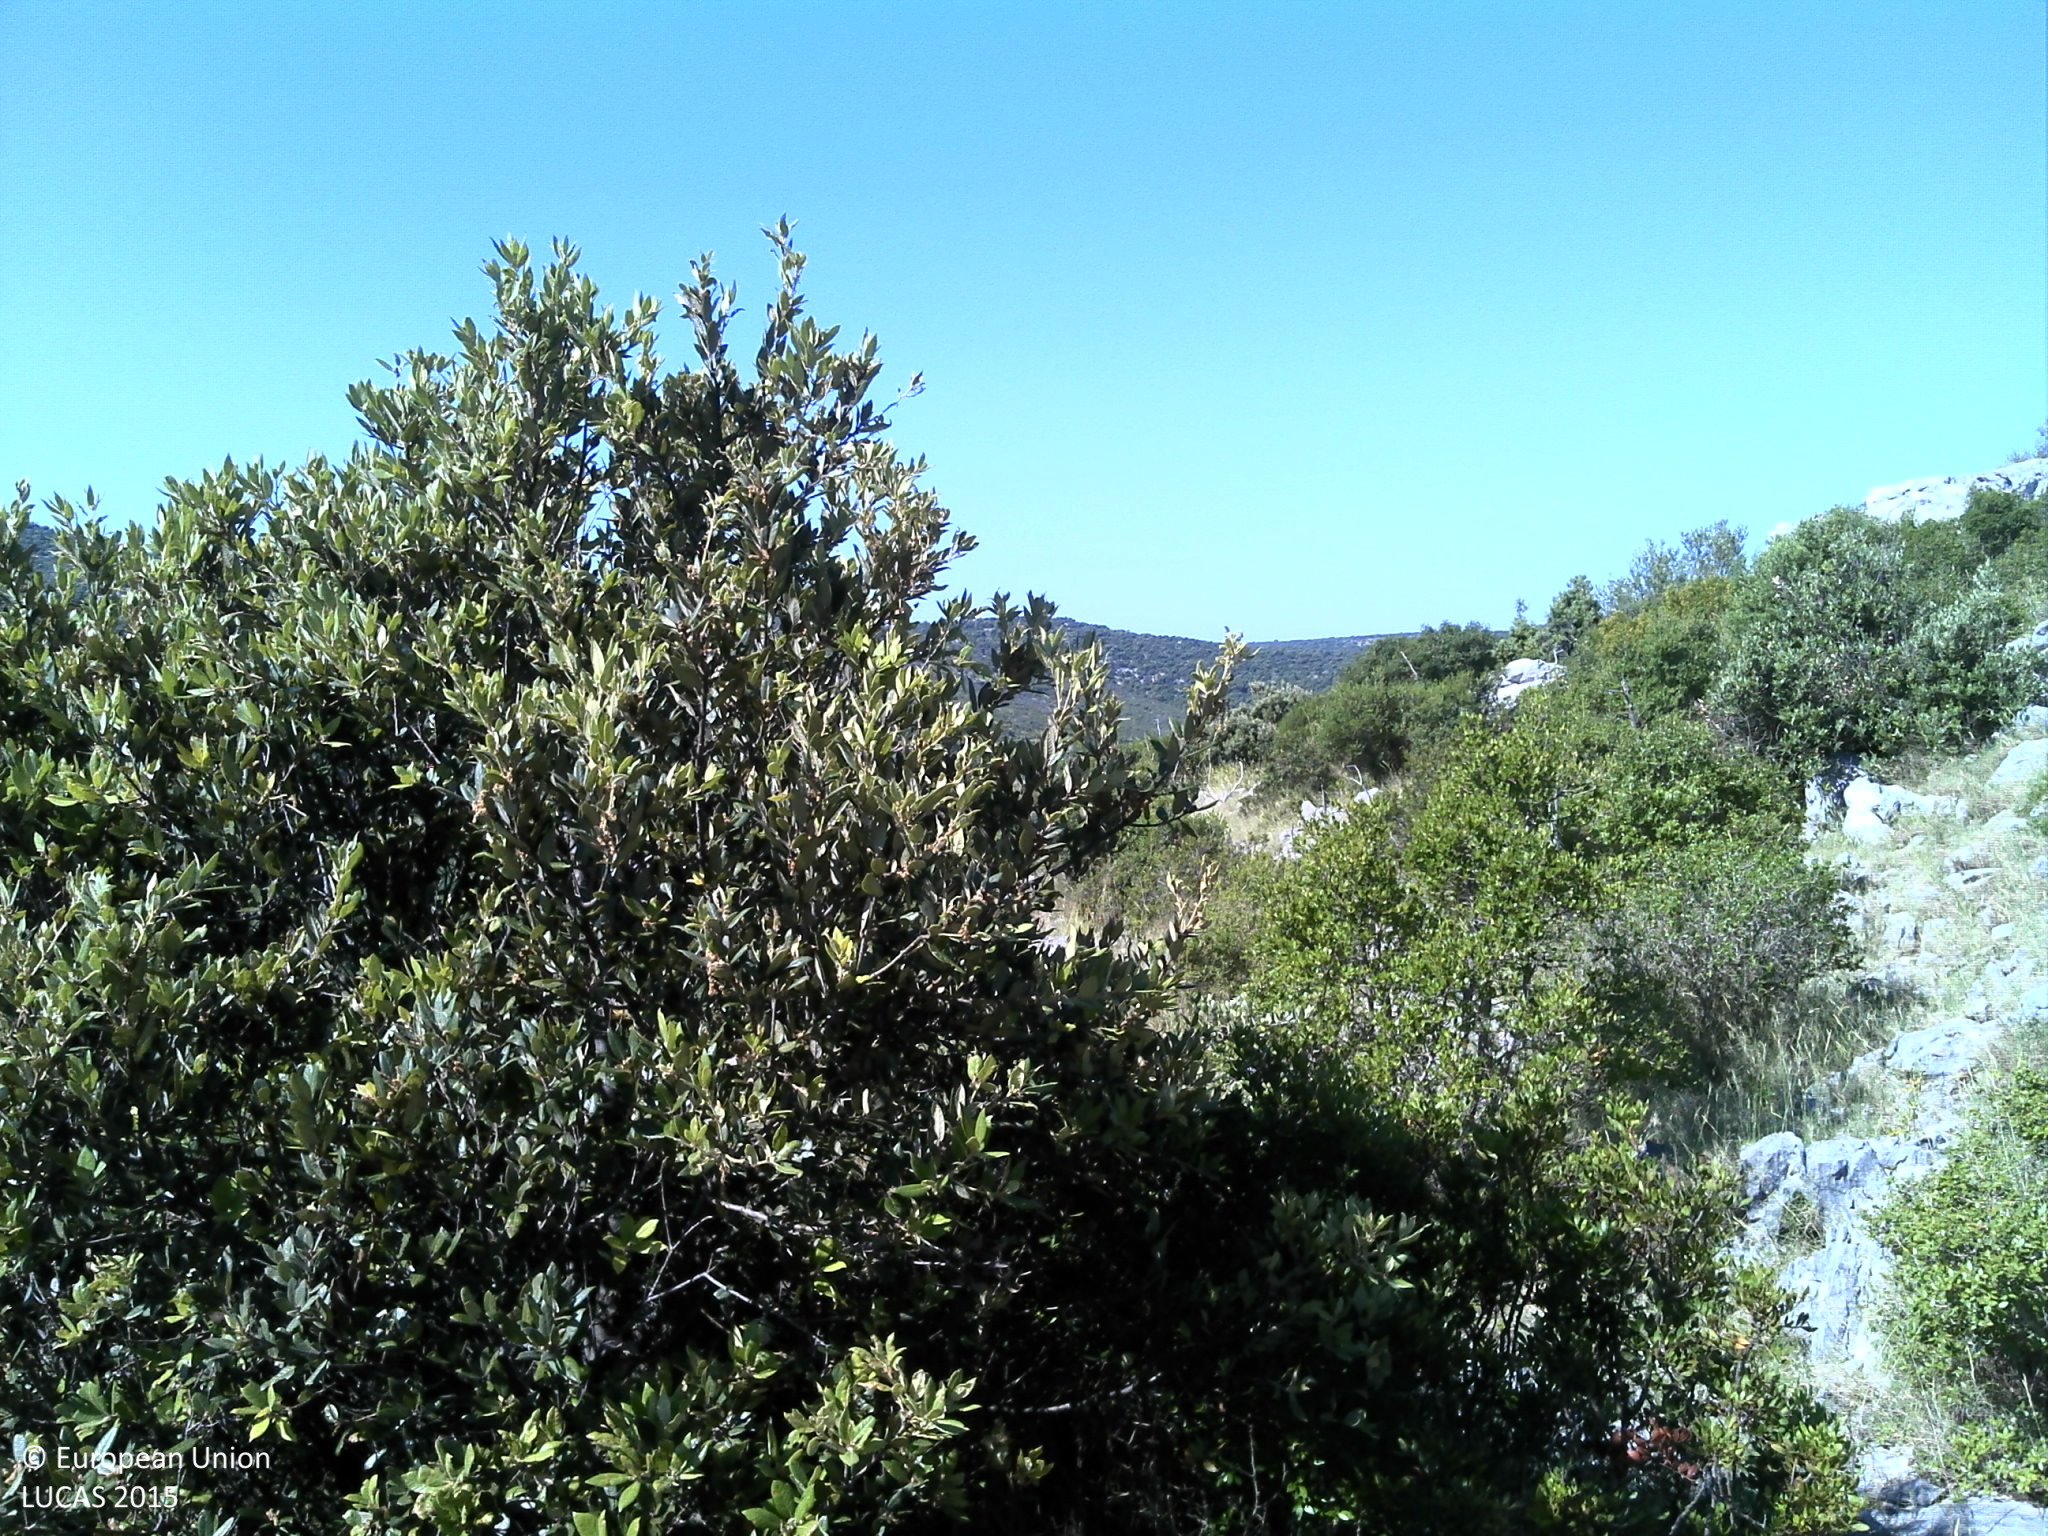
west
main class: Shrubland
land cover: Shrubland without tree cover
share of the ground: 25 - 50 %
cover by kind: shrubs 50 %, consolidated bare surface 20 %, unconsolidated bare surface 20 %, herbaceous plants 10 %
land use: Semi-natural and natural areas not in use
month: June
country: HR
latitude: 43.5205
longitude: 16.0896
